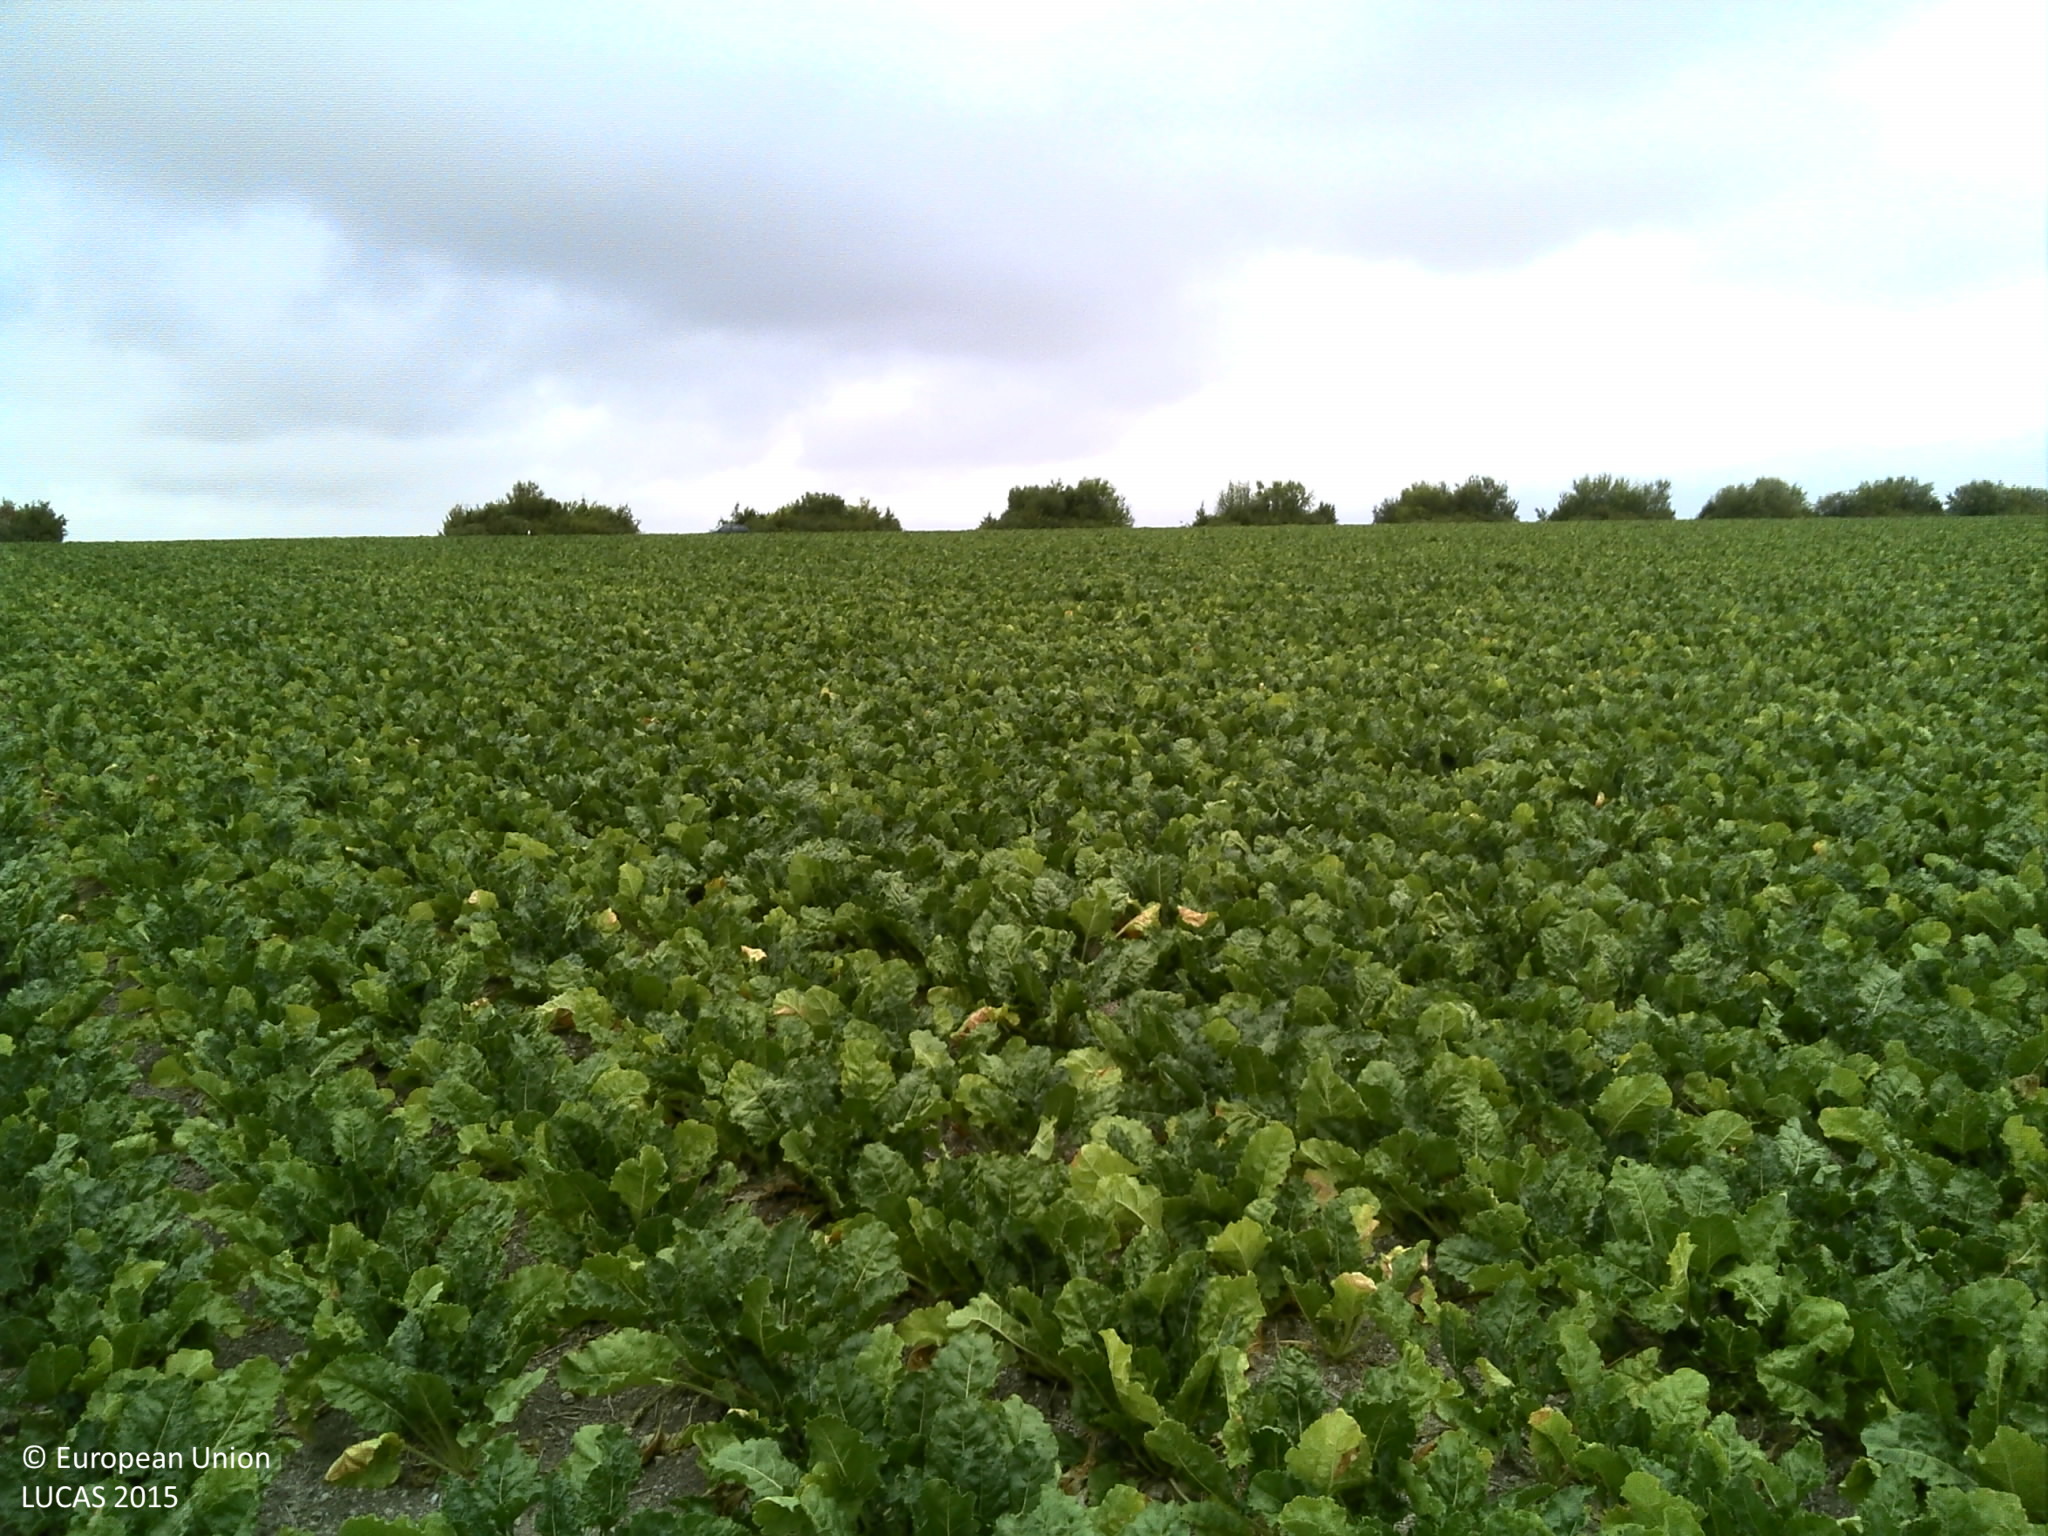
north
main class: Cropland
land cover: Sugar beet
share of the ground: 50 - 75 %
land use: Agriculture (excluding fallow land and kitchen gardens)
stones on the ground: < 10 %
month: August
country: FR
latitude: 48.7764
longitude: 4.2400
